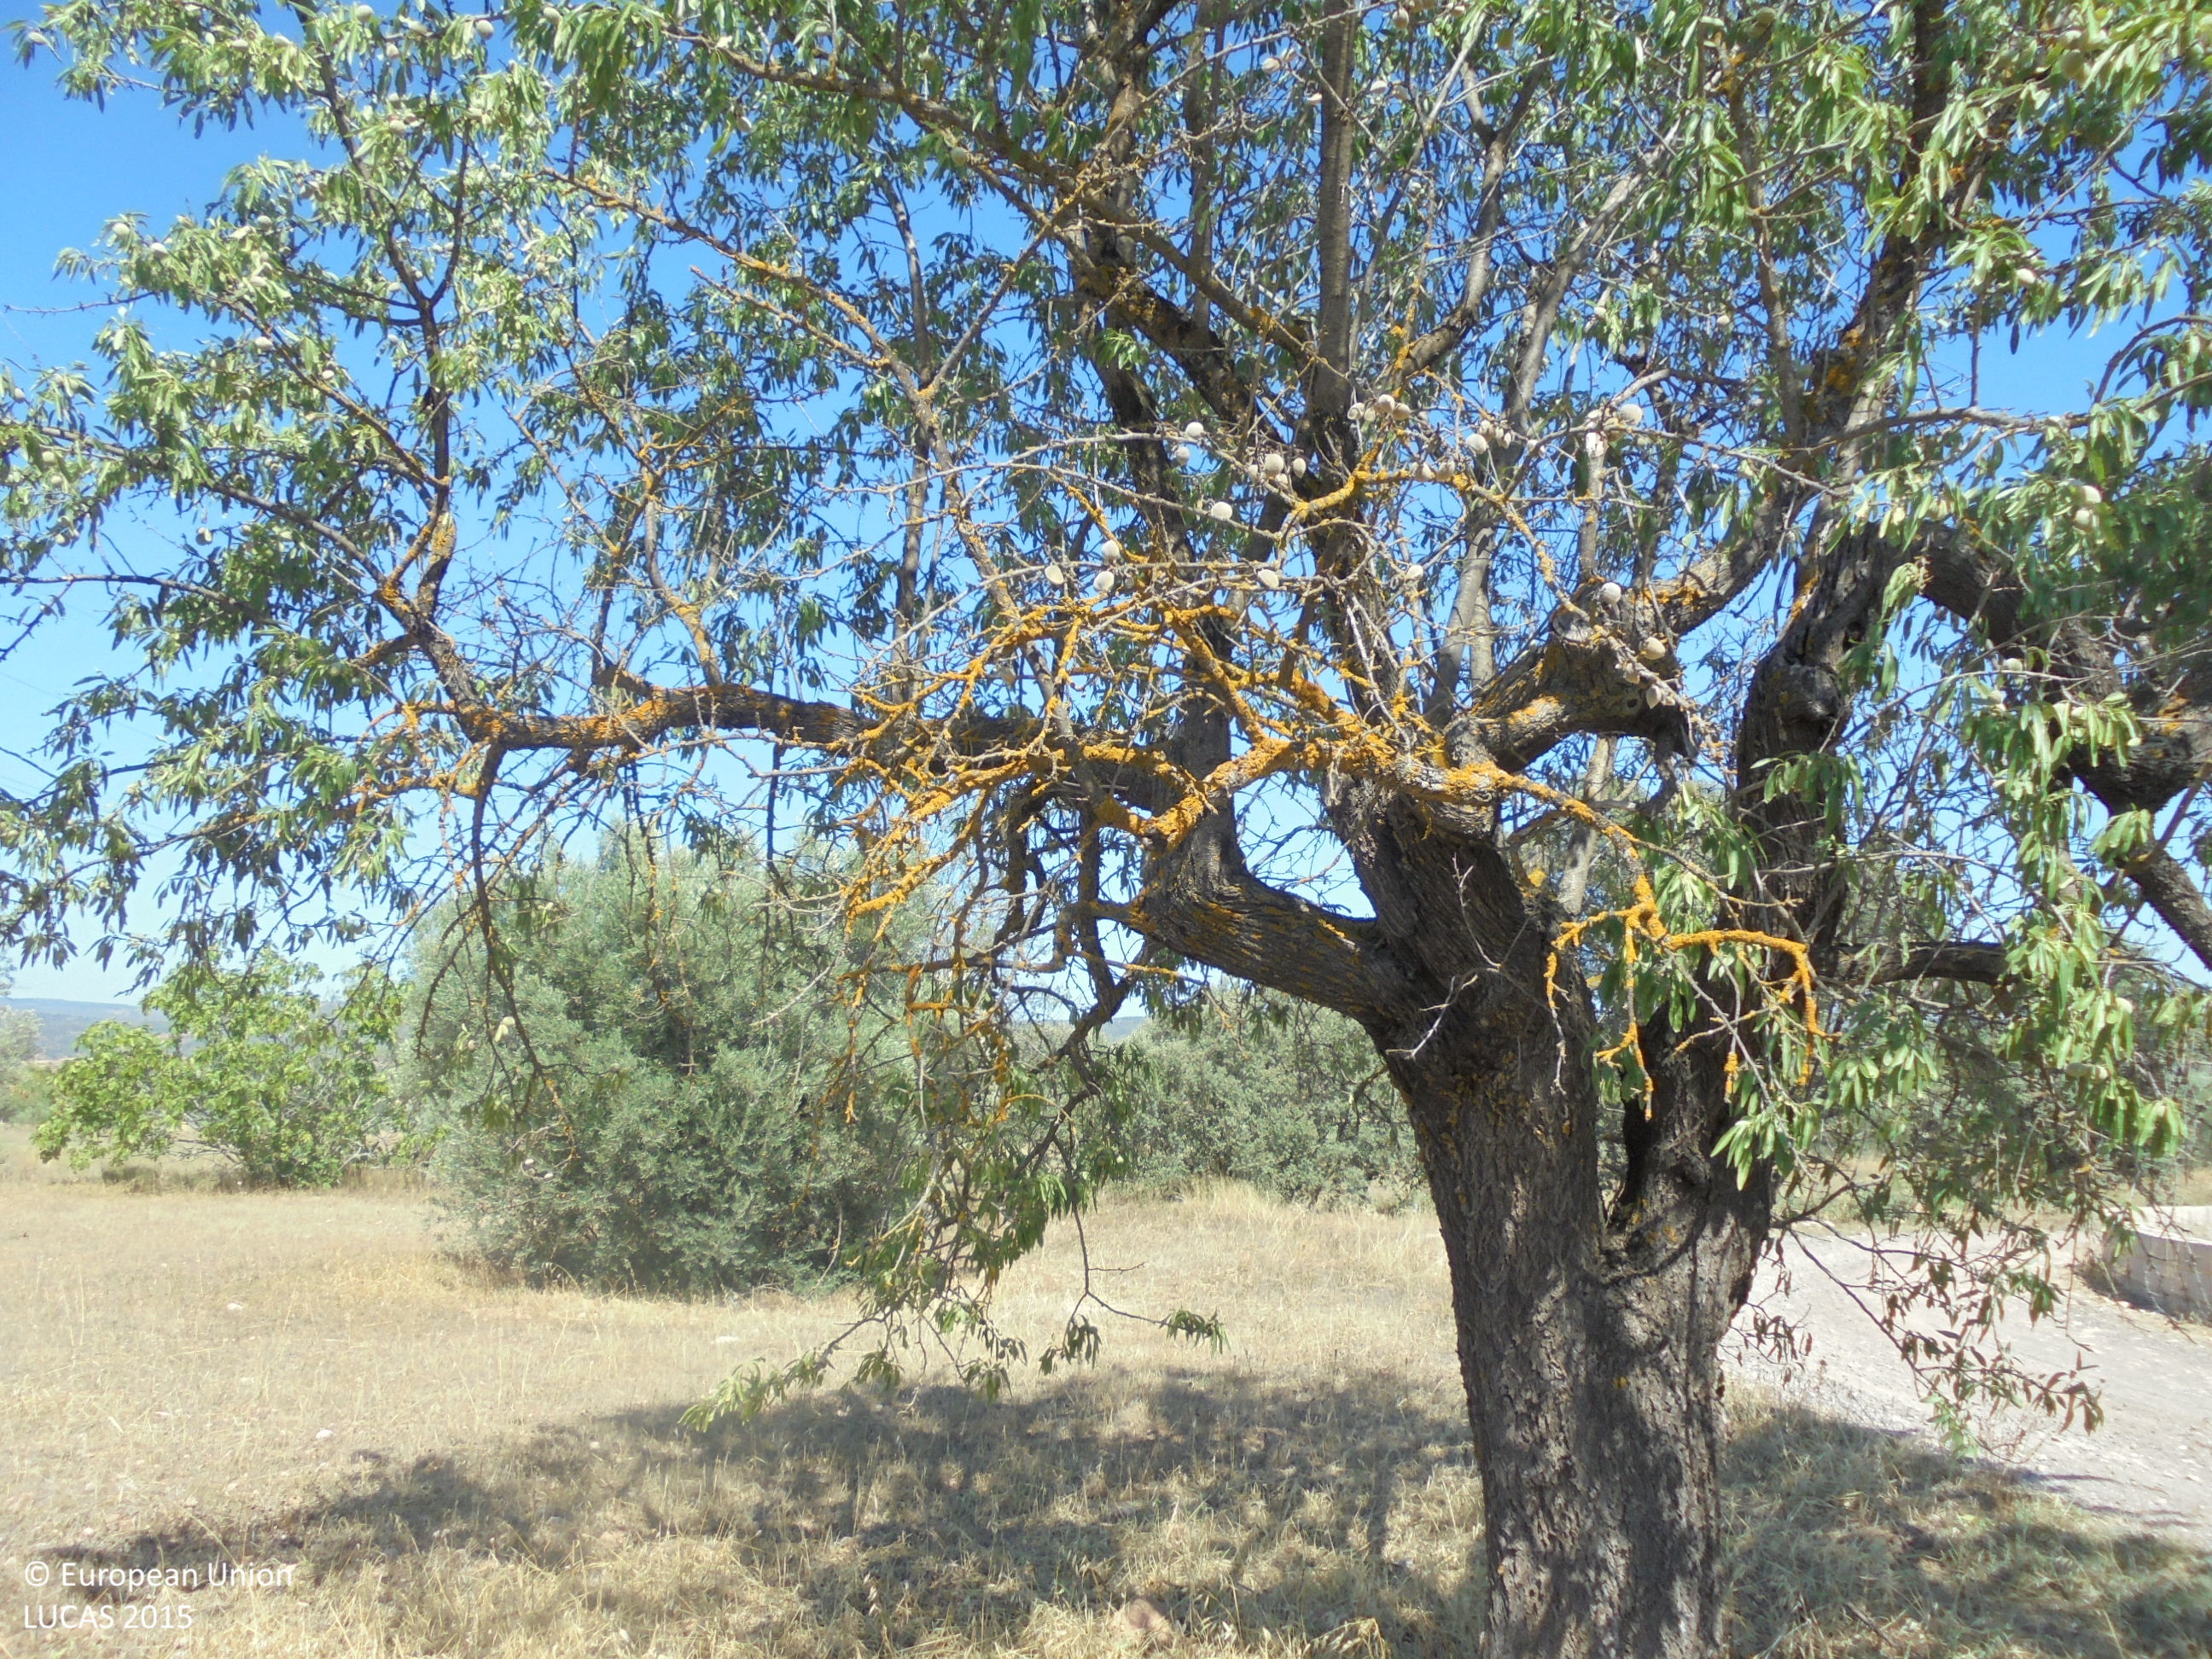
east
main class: Cropland
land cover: Nuts trees
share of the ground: 25 - 50 %
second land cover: Spontaneously vegetated surfaces
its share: 50 - 75 %
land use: Agriculture (excluding fallow land and kitchen gardens)
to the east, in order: Nuts trees; Spontaneously vegetated surfaces; Groves; Grassland without tree/shrub cover; Single bushes/trees; Grassland without tree/shrub cover; Olive groves; Fences; Groves
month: July
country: ES
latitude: 39.0385
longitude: -1.0521
